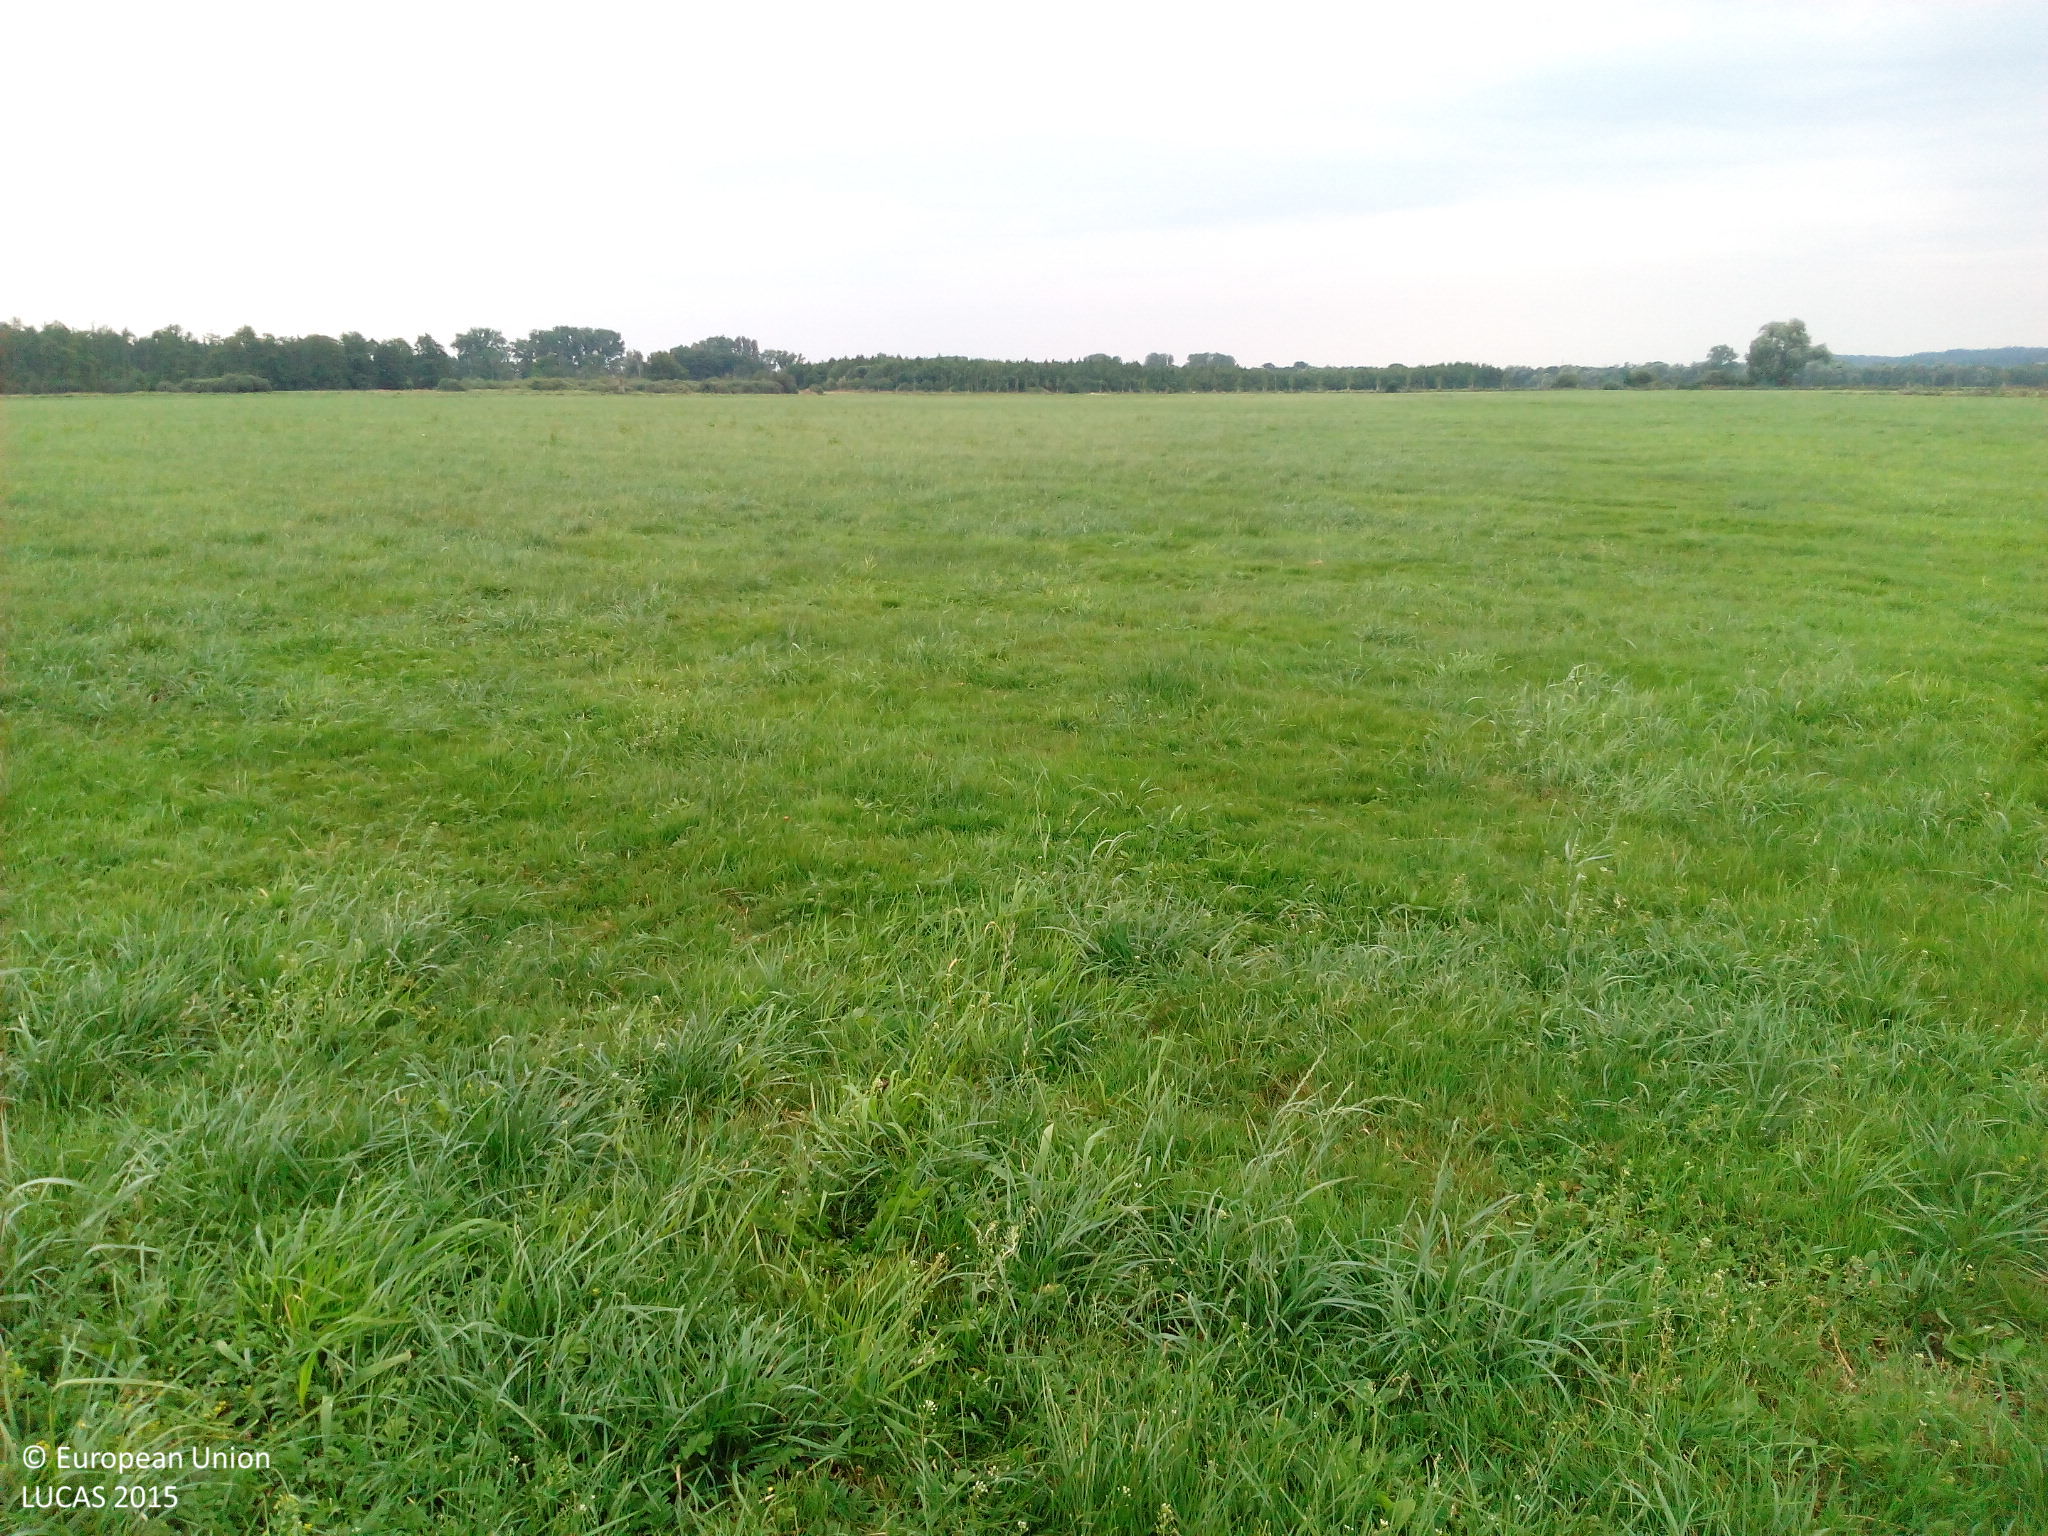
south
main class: Grassland
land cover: Grassland without tree/shrub cover
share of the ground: > 75 %
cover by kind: herbaceous plants 100 %
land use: Agriculture (excluding fallow land and kitchen gardens)
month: August
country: DE
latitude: 53.8237
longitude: 12.5969
